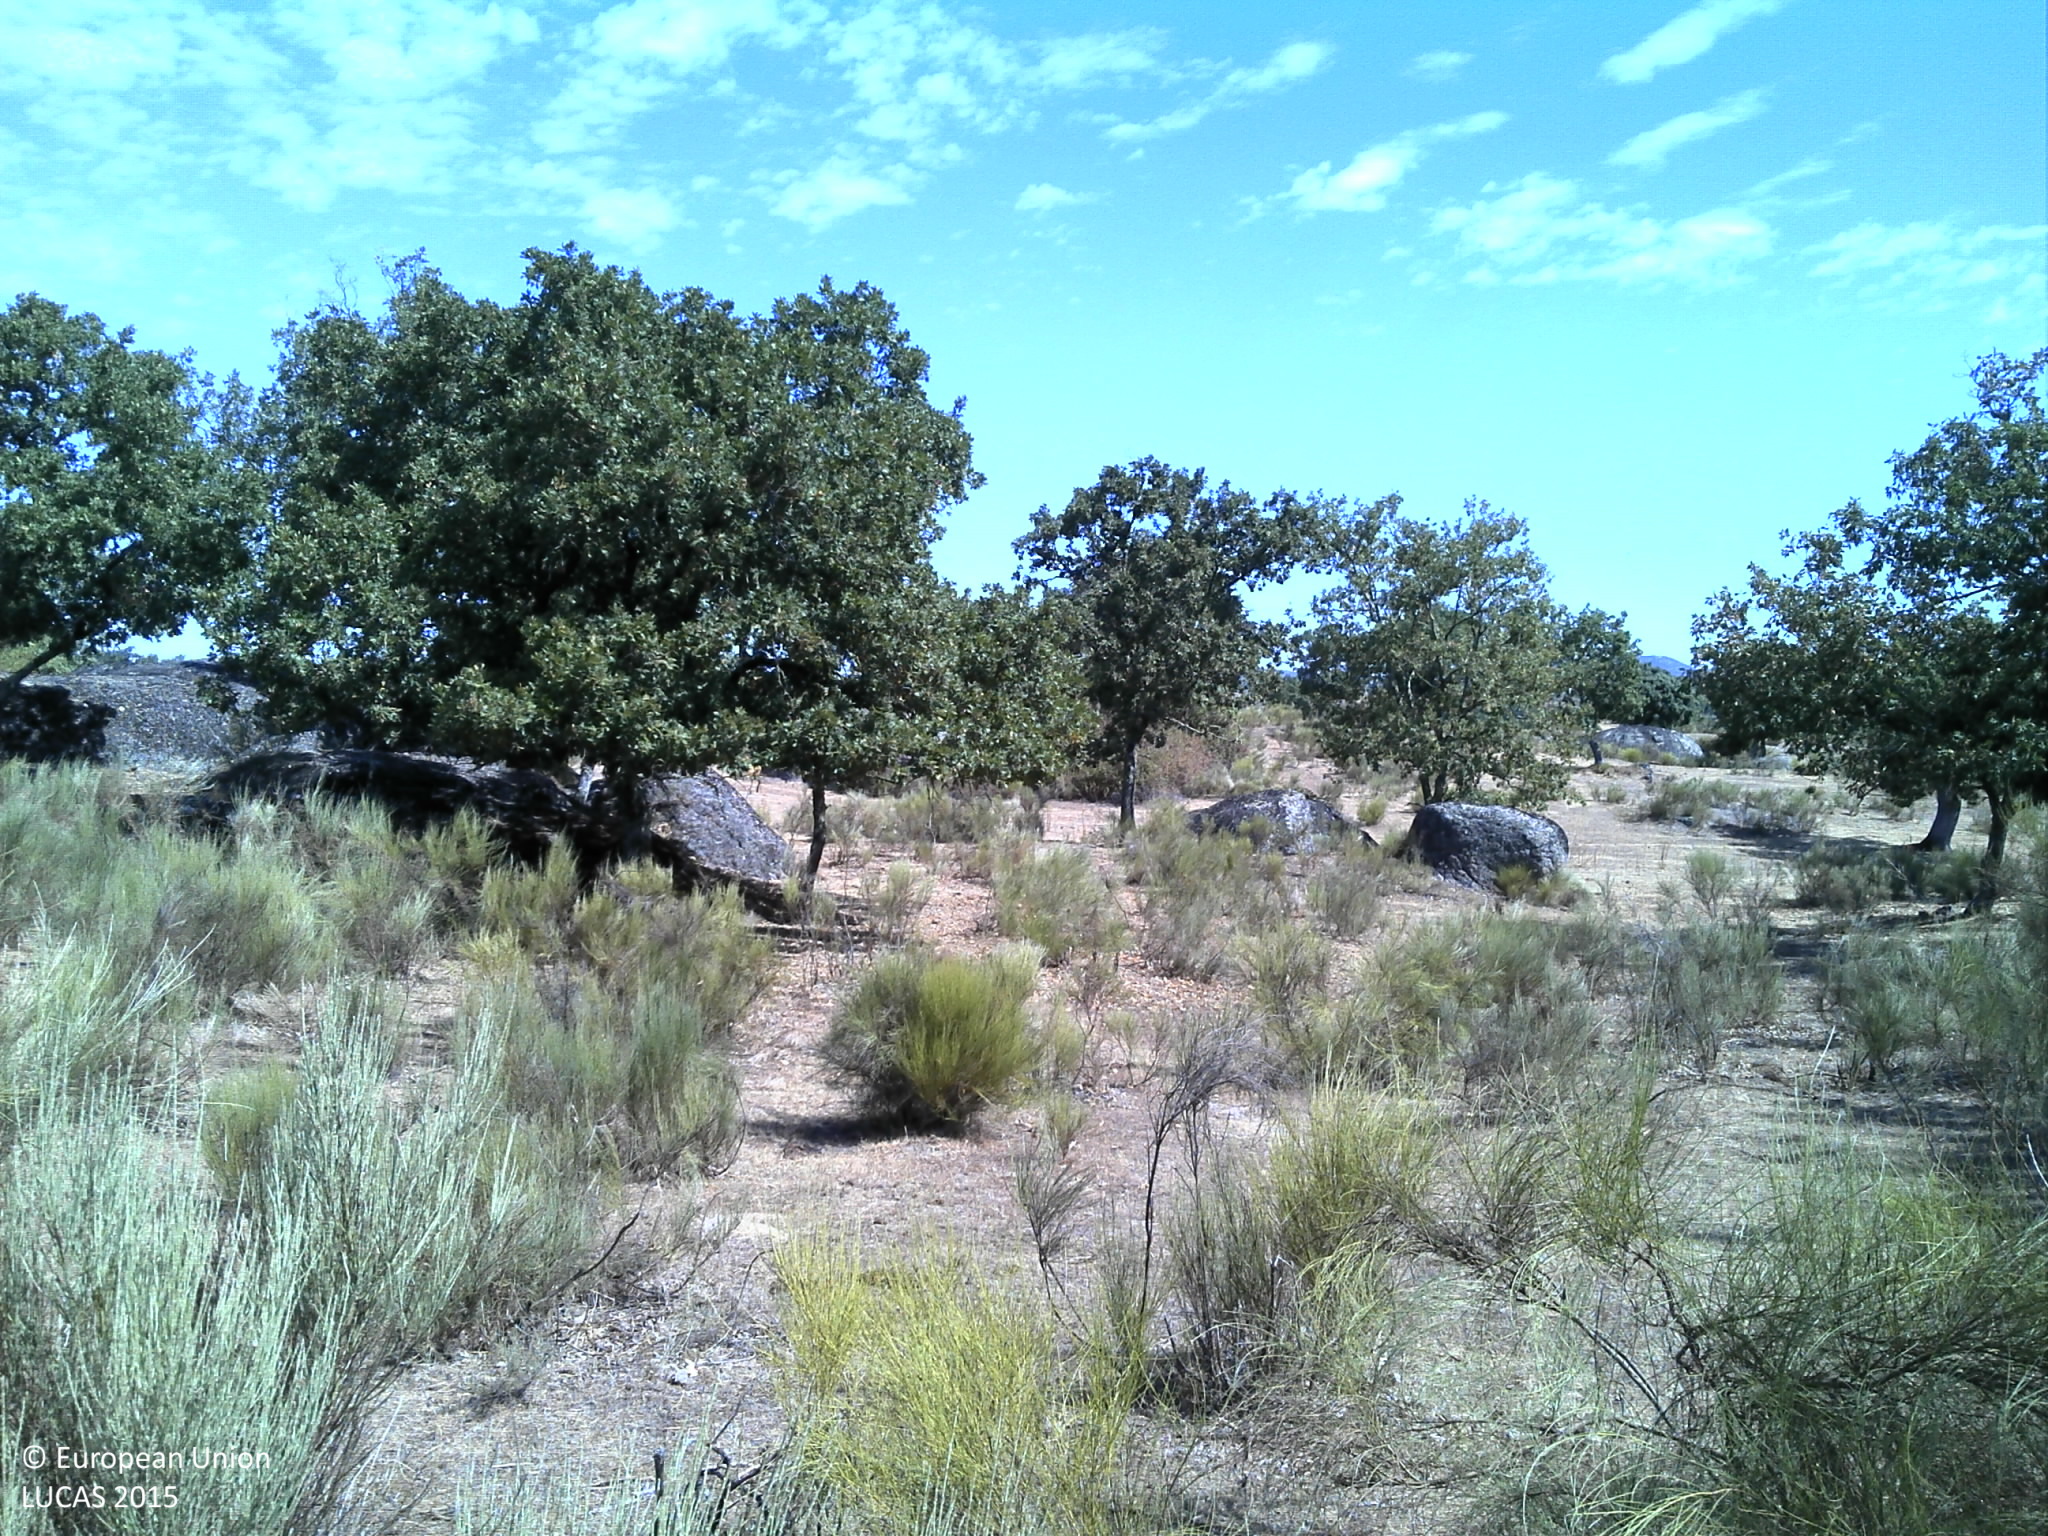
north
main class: Woodland
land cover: Broadleaved woodland
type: broadleaved evergreen forest
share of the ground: 25 - 50 %
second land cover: Shrubland without tree cover
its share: > 75 %
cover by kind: shrubs 70 %, broadleaved forest trees 25 %, herbaceous plants 5 %
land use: Forestry
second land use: Agriculture (excluding fallow land and kitchen gardens)
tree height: > 5 m
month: August
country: PT
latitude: 39.4989
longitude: -7.6684
